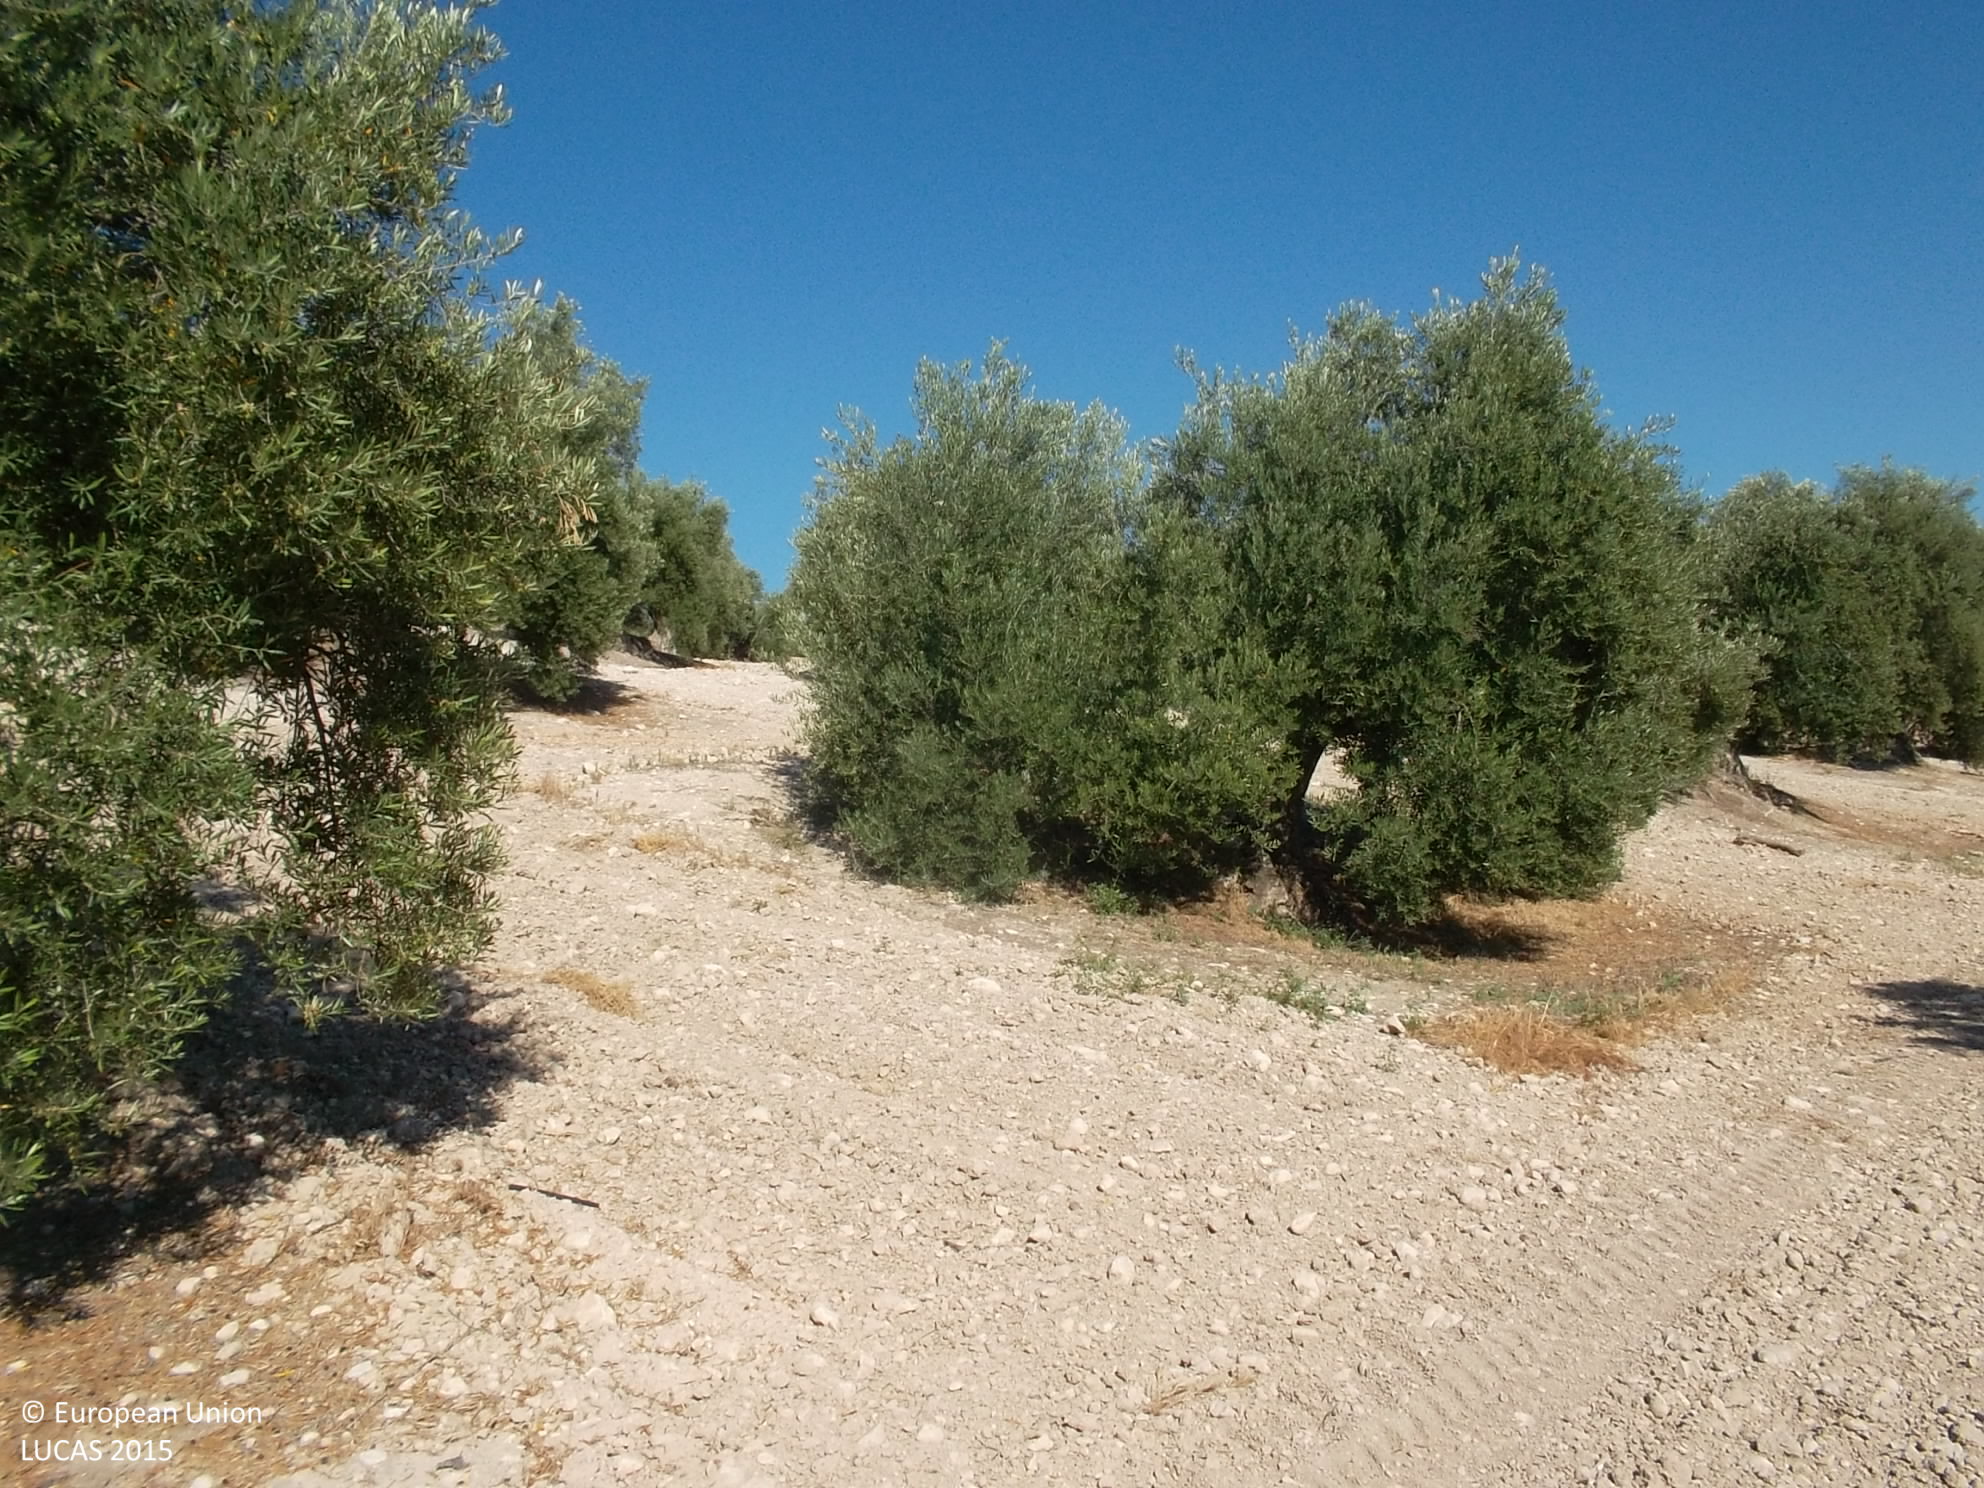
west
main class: Cropland
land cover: Olive groves
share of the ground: 25 - 50 %
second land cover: Other bare soil
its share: > 75 %
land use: Agriculture (excluding fallow land and kitchen gardens)
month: June
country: ES
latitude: 37.8864
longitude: -3.3353
